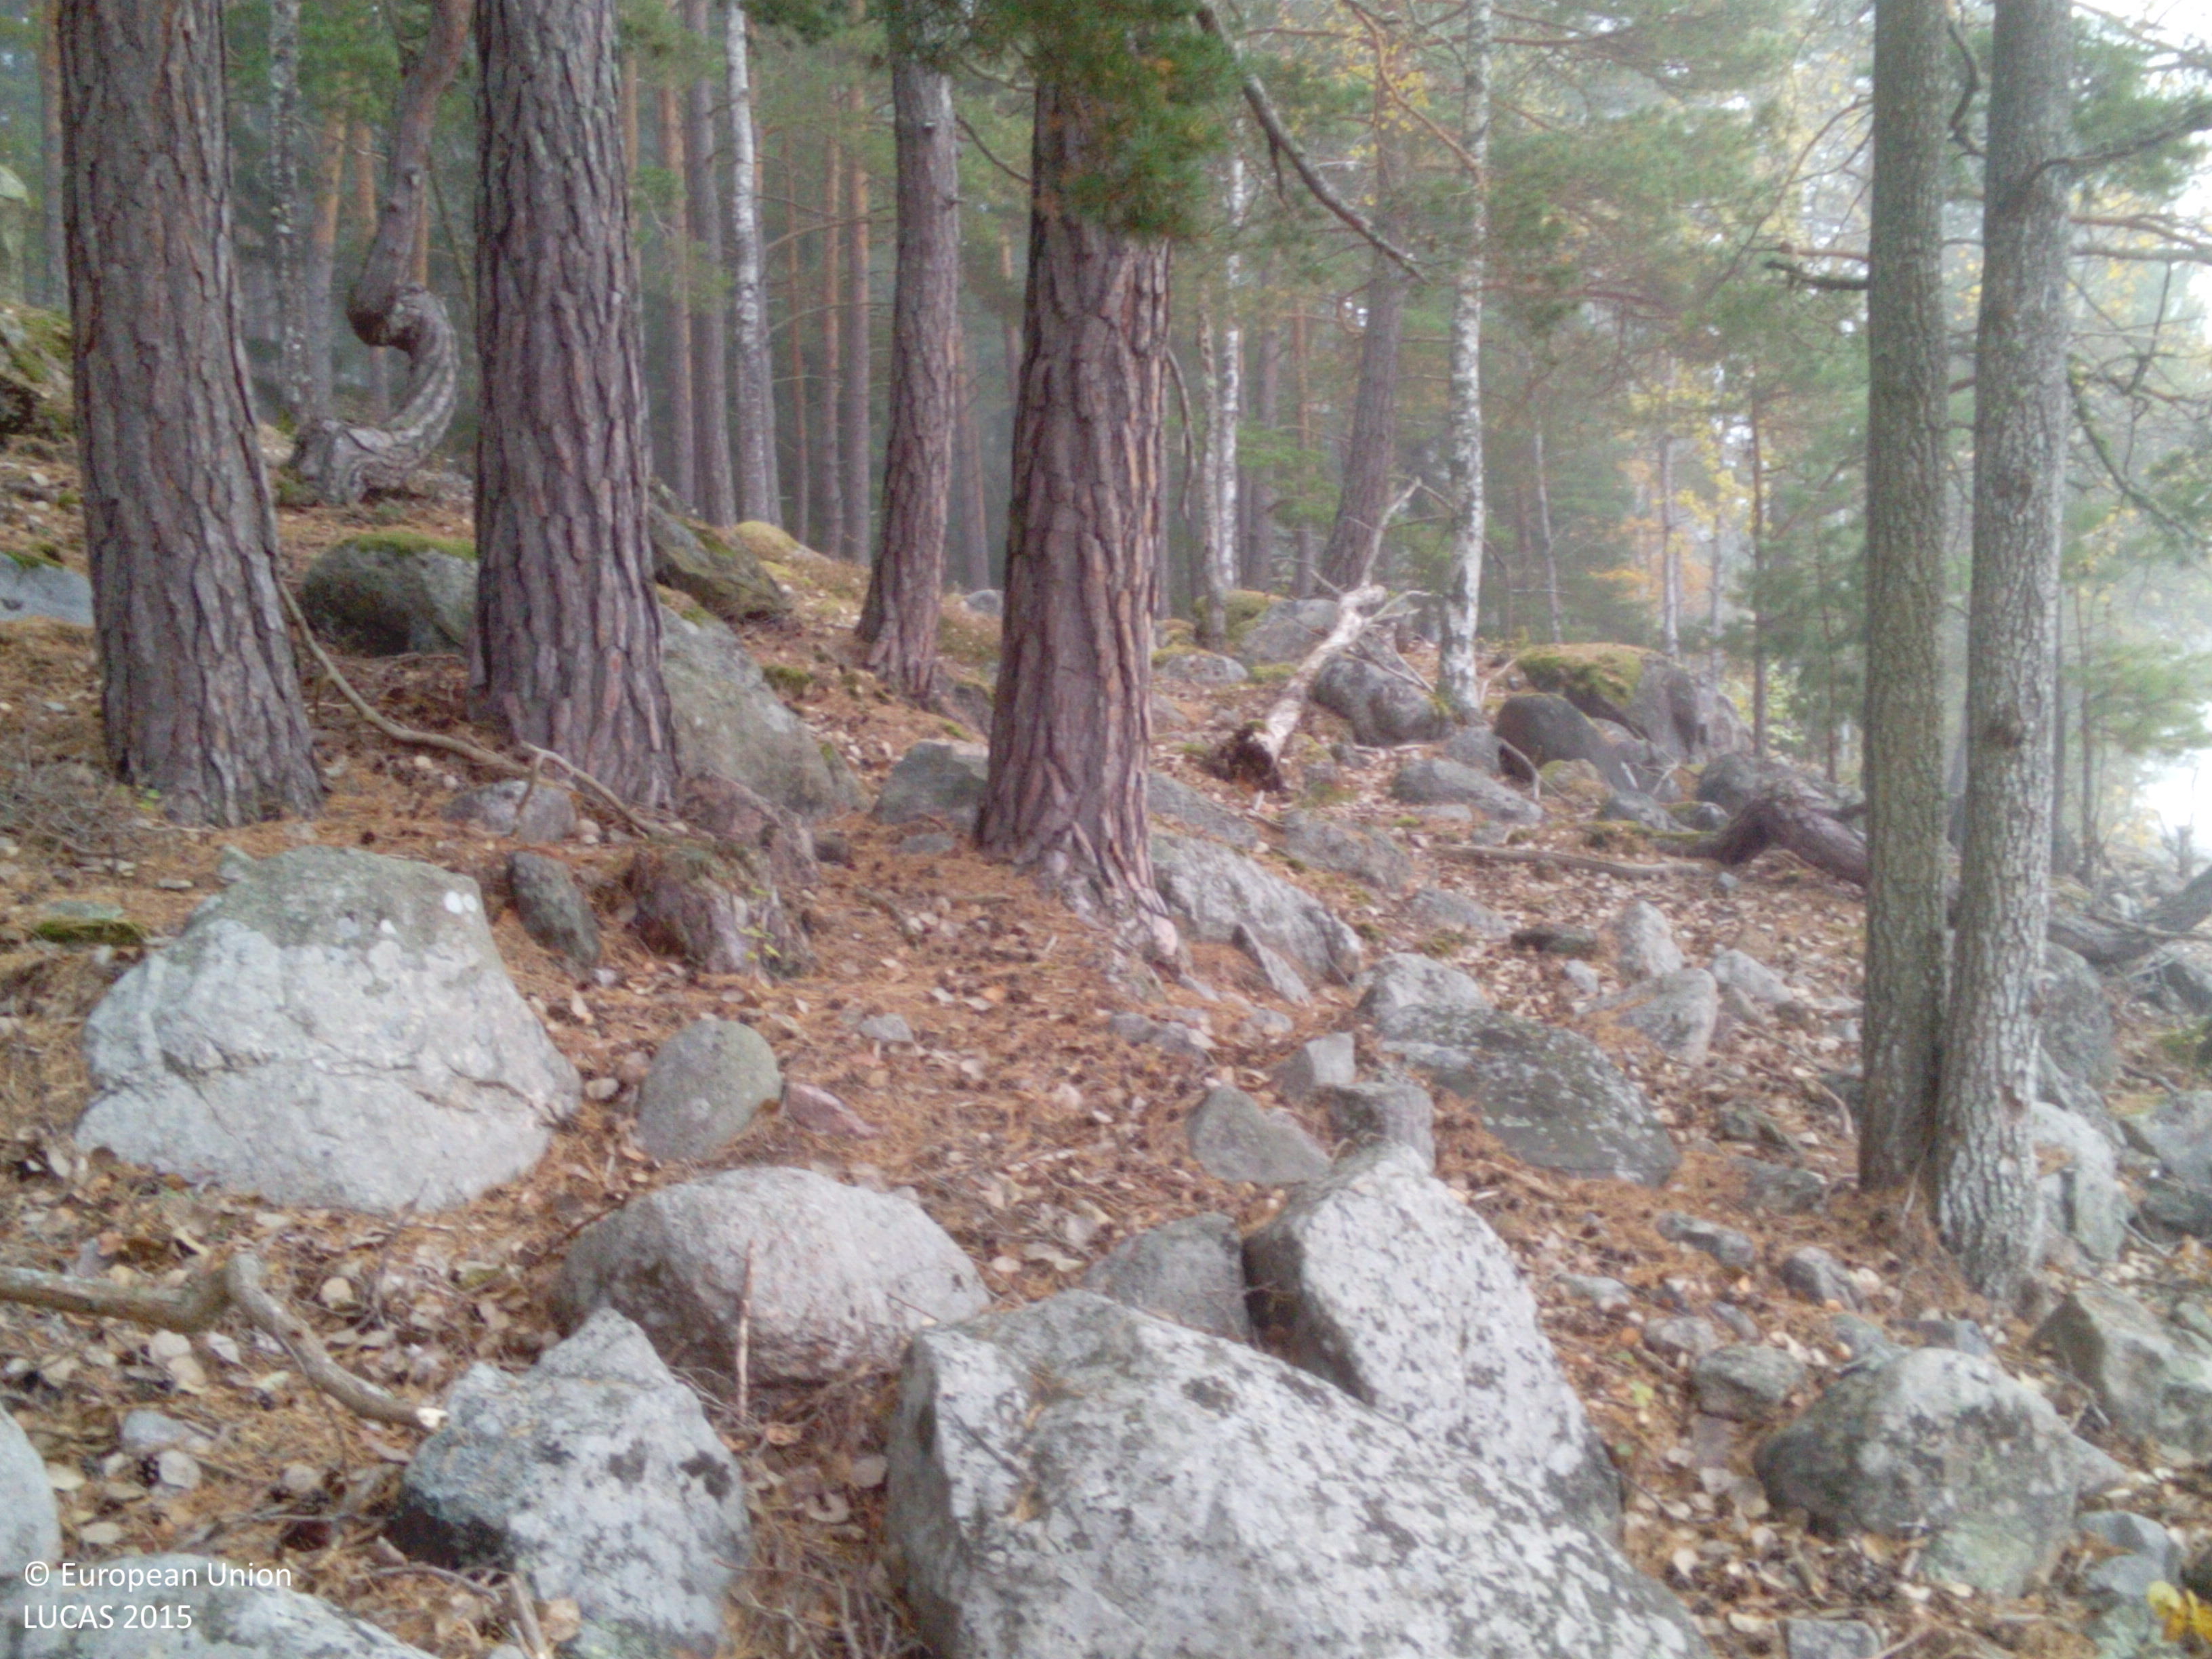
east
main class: Woodland
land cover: Pine dominated coniferous woodland
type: boreal forest
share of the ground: 25 - 50 %
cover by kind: coniferous forest trees 45 %
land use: Forestry
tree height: > 5 m
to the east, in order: Shruby margins; Pine dominated coniferous woodland
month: October
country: SE
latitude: 58.9448
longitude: 16.5468
